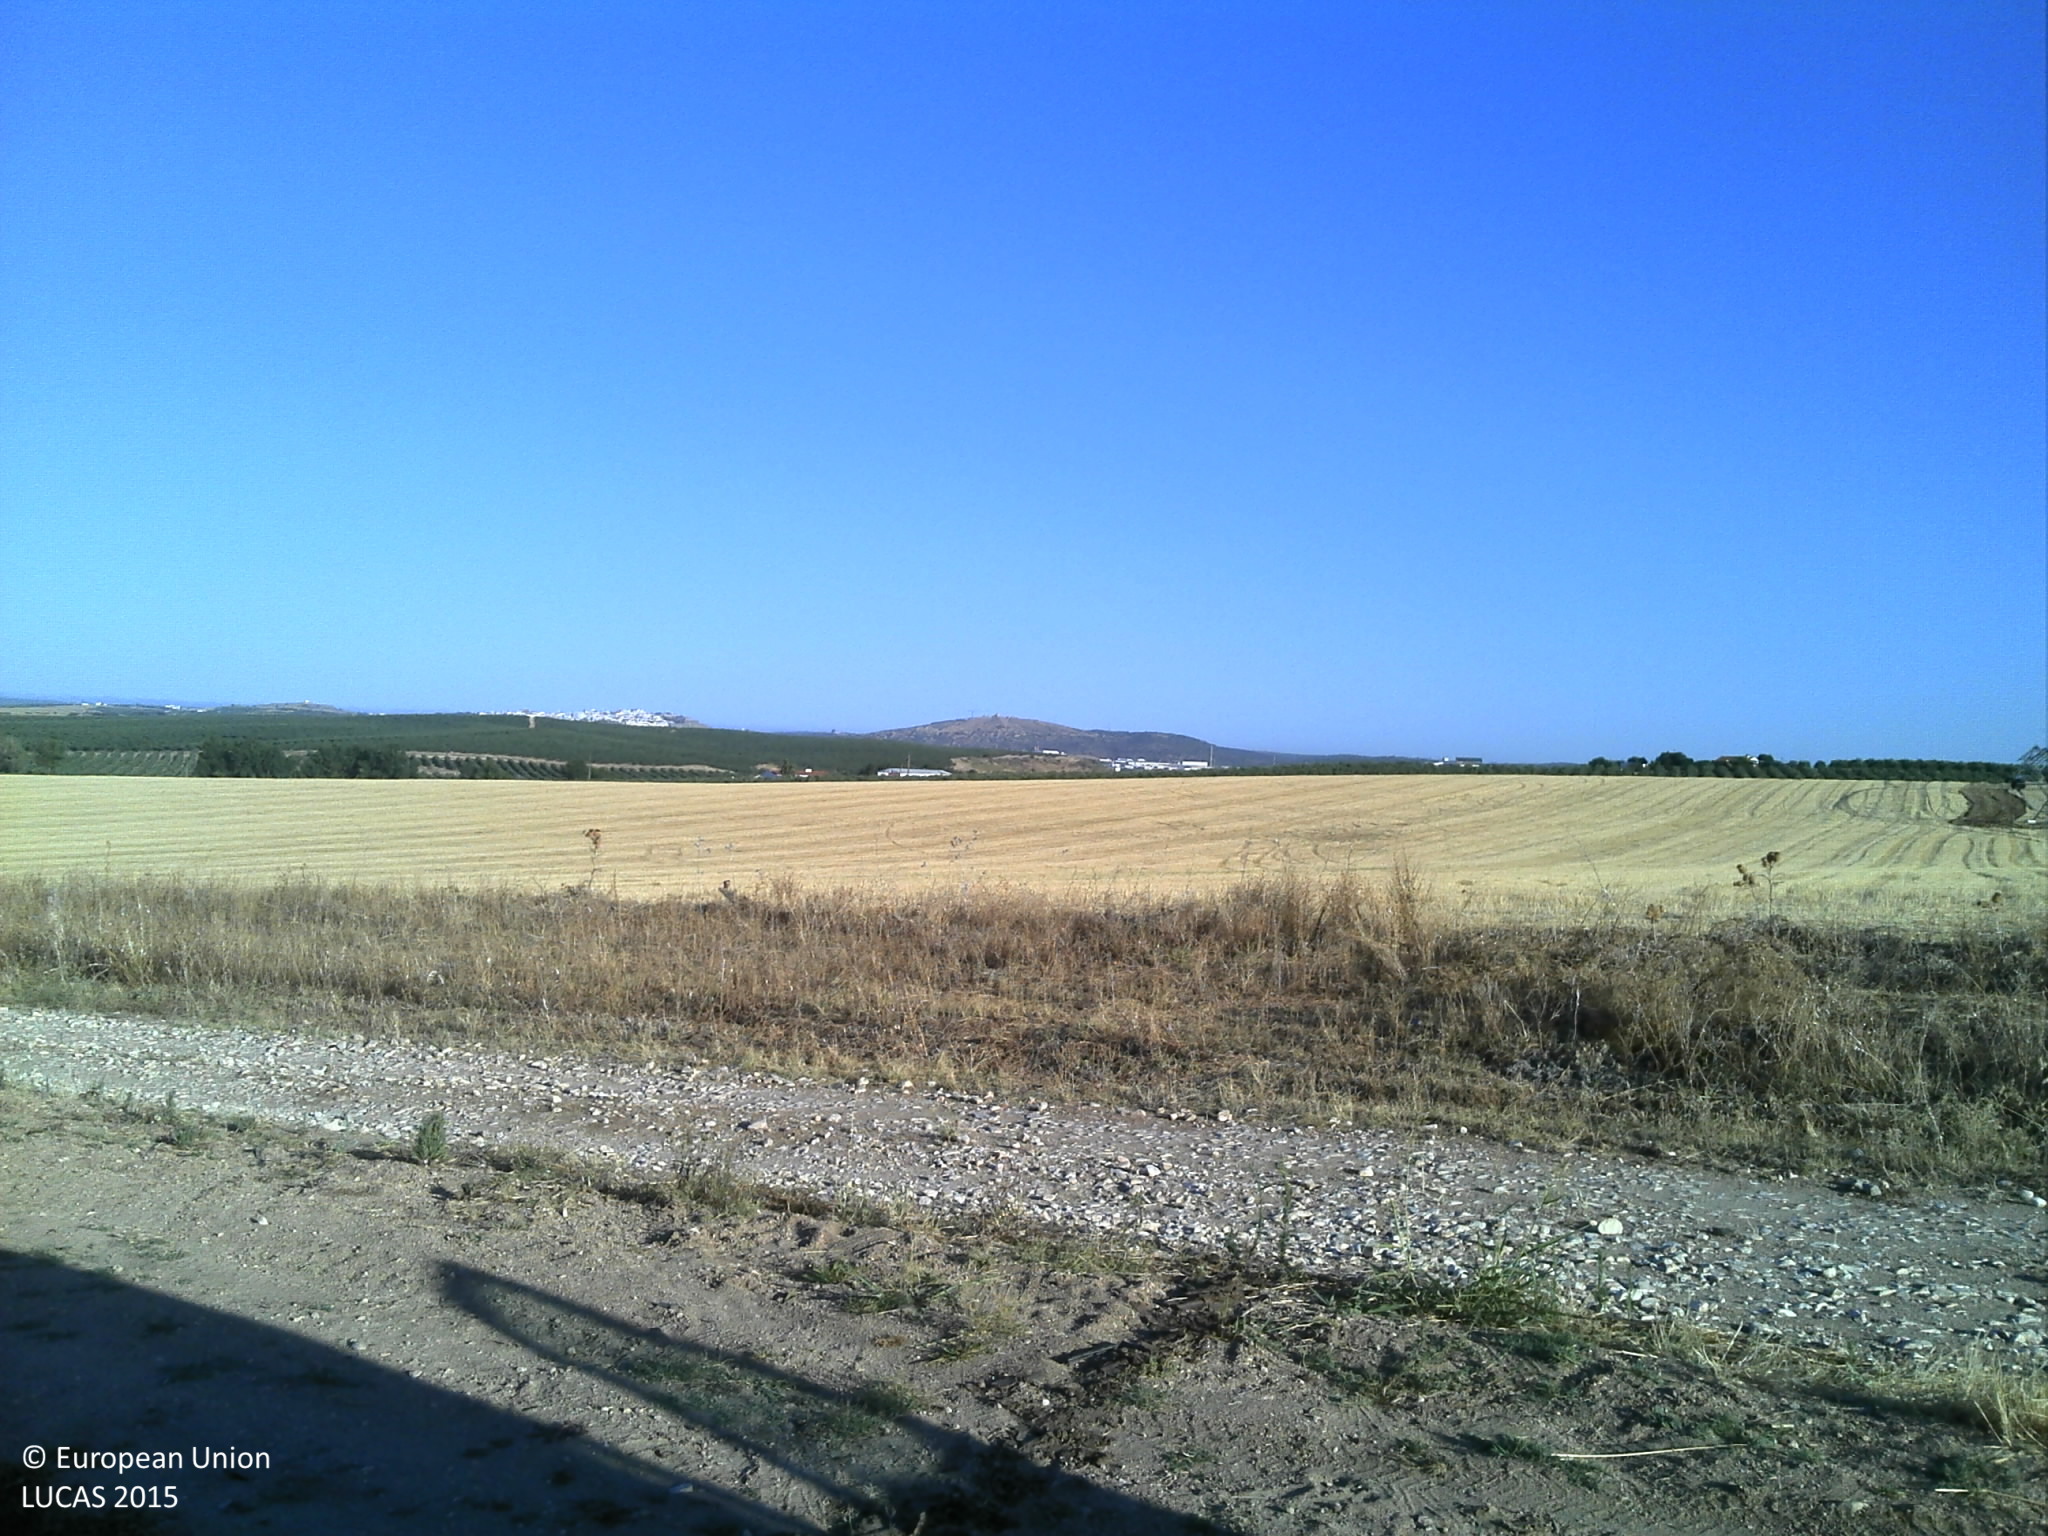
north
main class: Cropland
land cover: Tomatoes
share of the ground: > 75 %
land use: Agriculture (excluding fallow land and kitchen gardens)
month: July
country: PT
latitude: 38.8651
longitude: -7.0945
